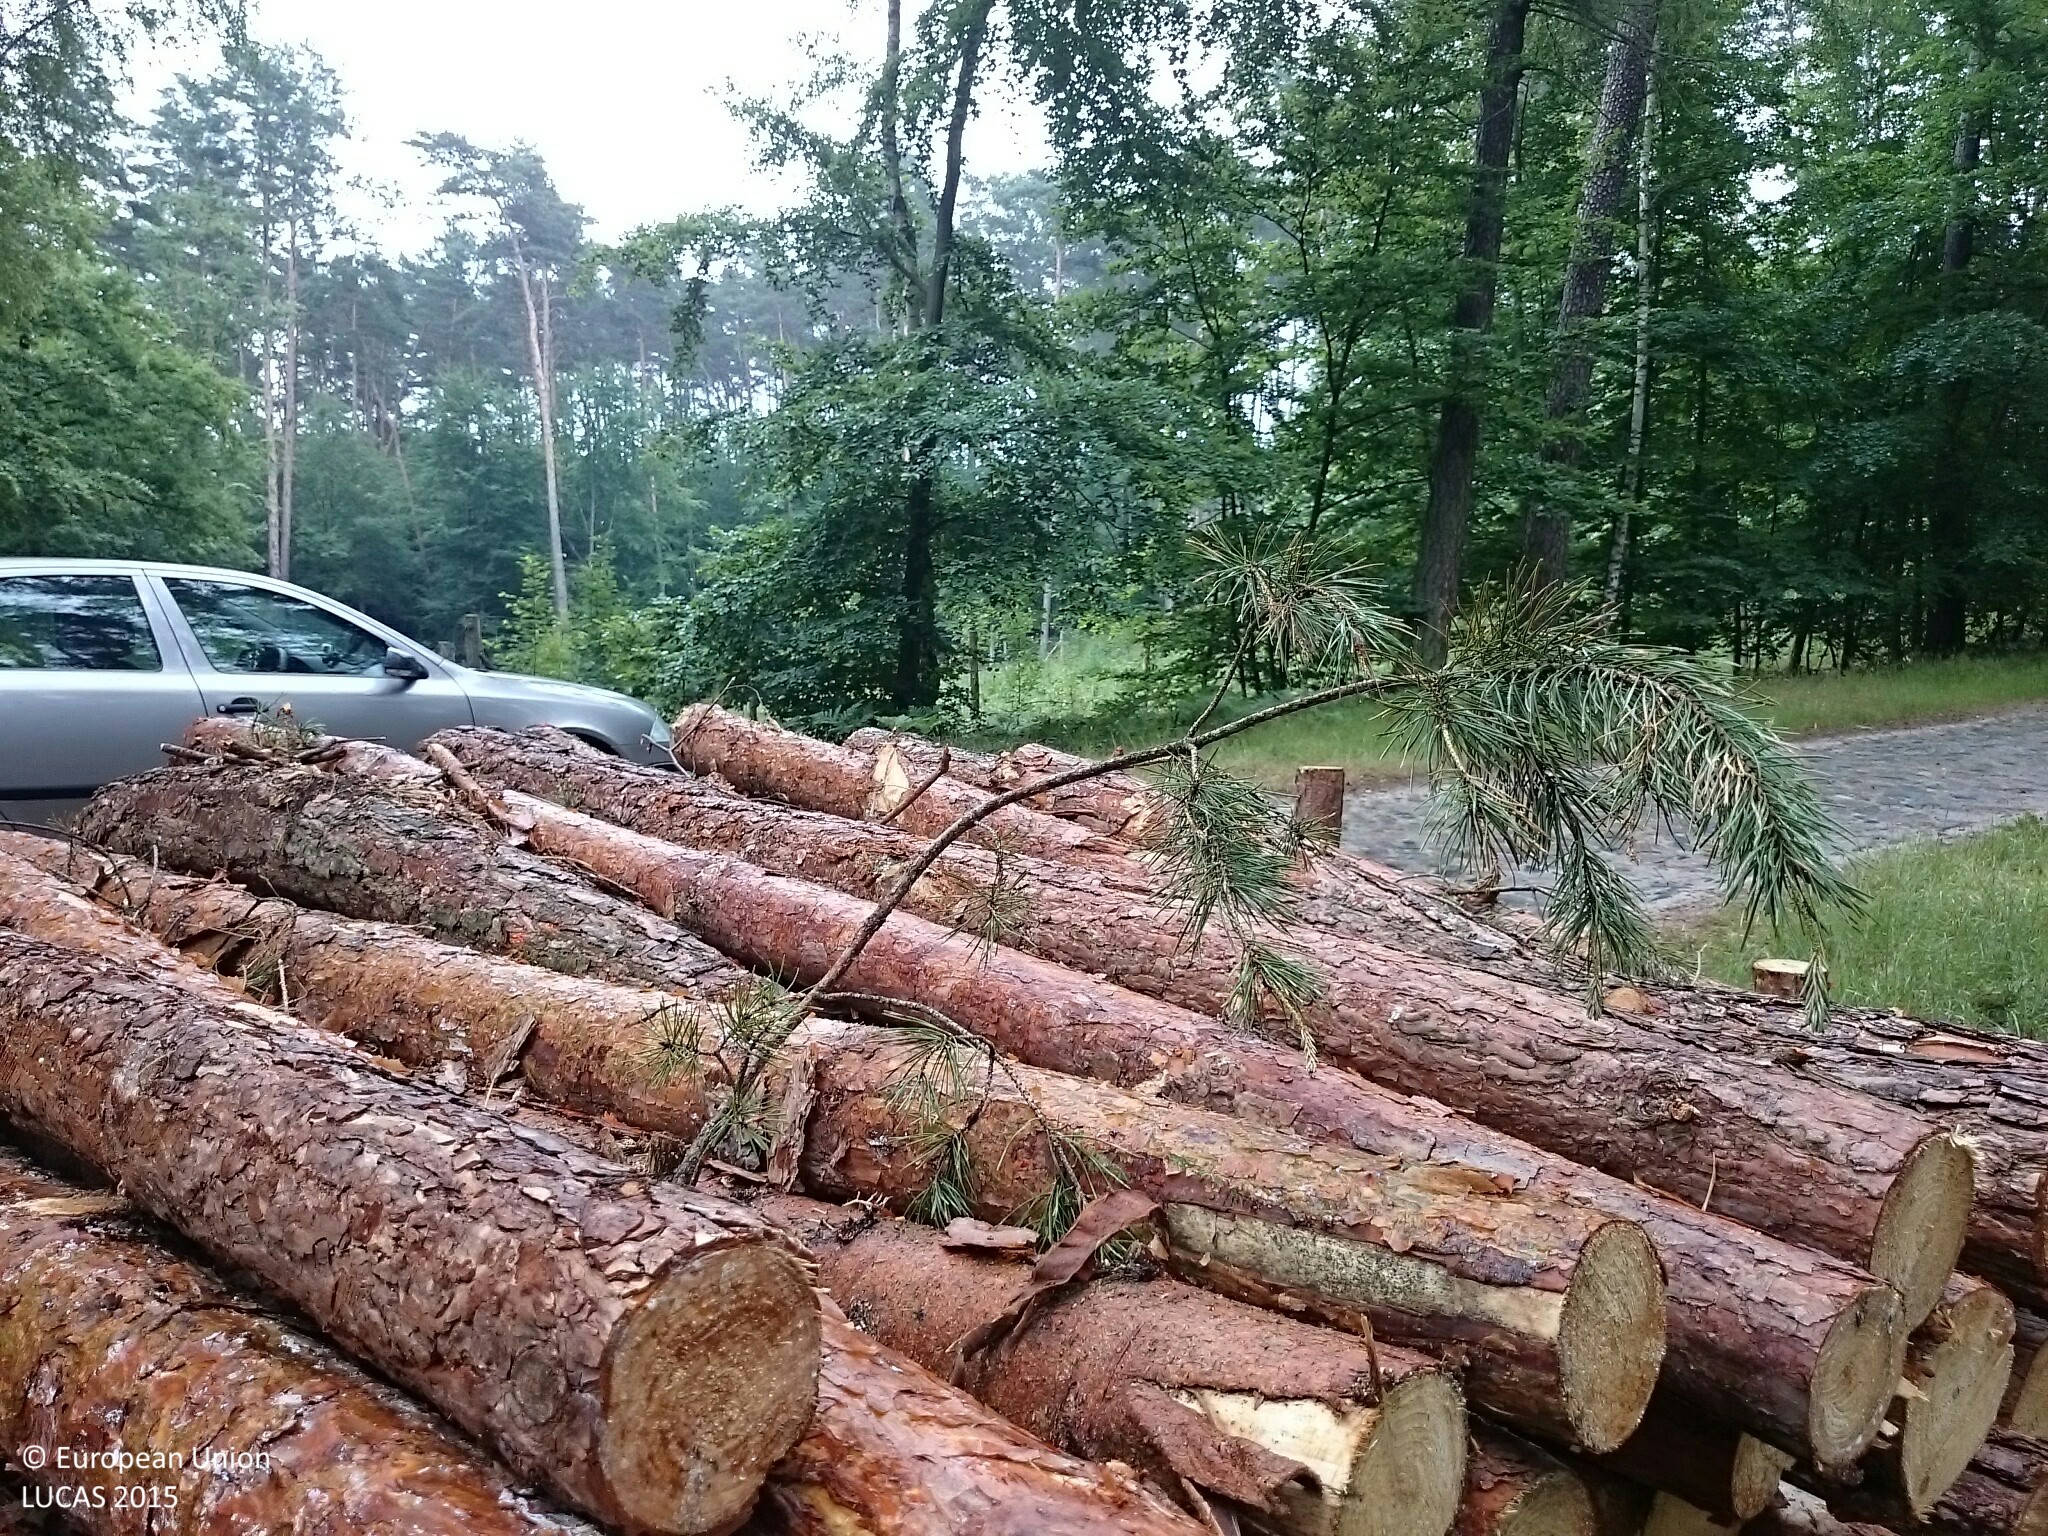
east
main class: Woodland
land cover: Pine dominated coniferous woodland
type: hemiboreal forest and nemoral coniferous forest and mixed broadleaved-coniferous forest
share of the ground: > 75 %
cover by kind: coniferous forest trees 90 %, broadleaved forest trees 5 %, consolidated bare surface 5 %
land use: Forestry
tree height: > 5 m
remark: Clear cut
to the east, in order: Pine dominated coniferous woodland; Paved roads, cycling and walking lanes; Grass margins; Broadleaved woodland; Grass margins; Fences; Shrubland without tree cover; Fences; Pine dominated coniferous woodland; Tracks; Pine dominated coniferous woodland; Tracks; Broadleaved woodland
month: June
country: PL
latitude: 52.9253
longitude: 15.7014
